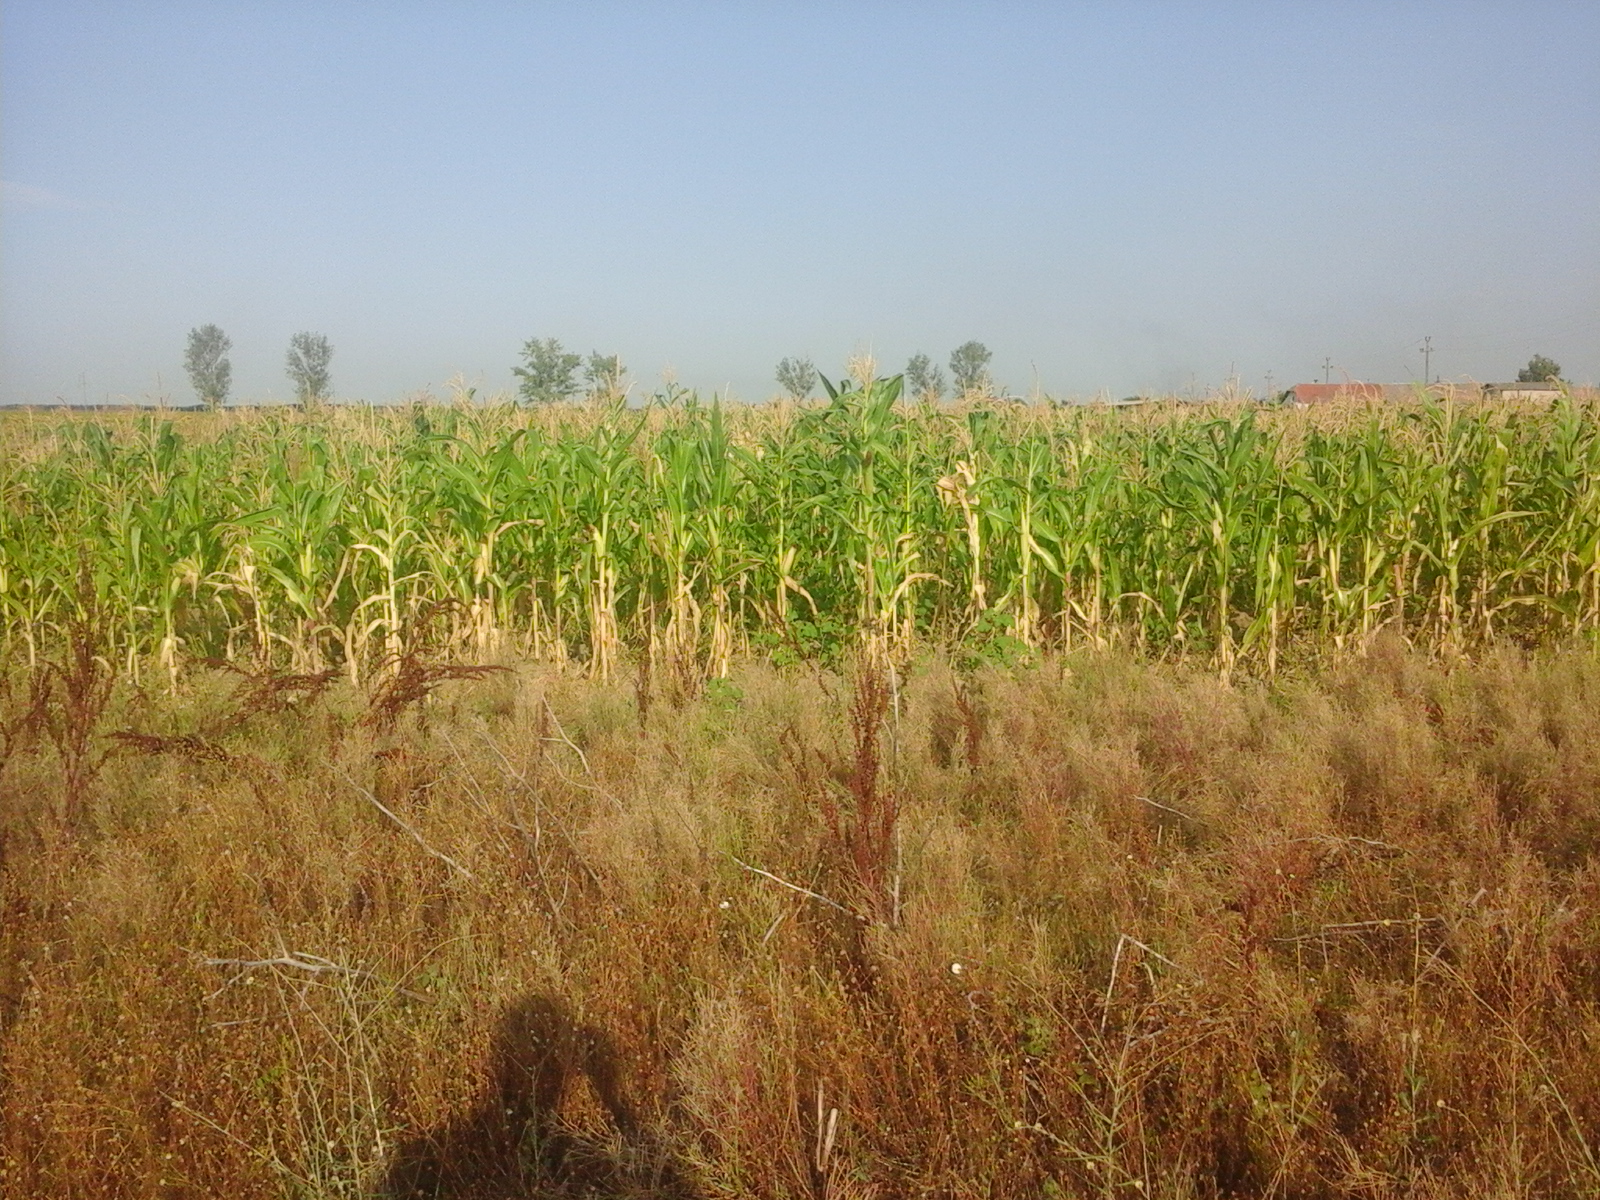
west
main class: Grassland
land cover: Spontaneously vegetated surfaces
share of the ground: > 75 %
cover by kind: herbaceous plants 100 %
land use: Fallow land
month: August
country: RO
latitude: 44.1582
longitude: 23.7720
